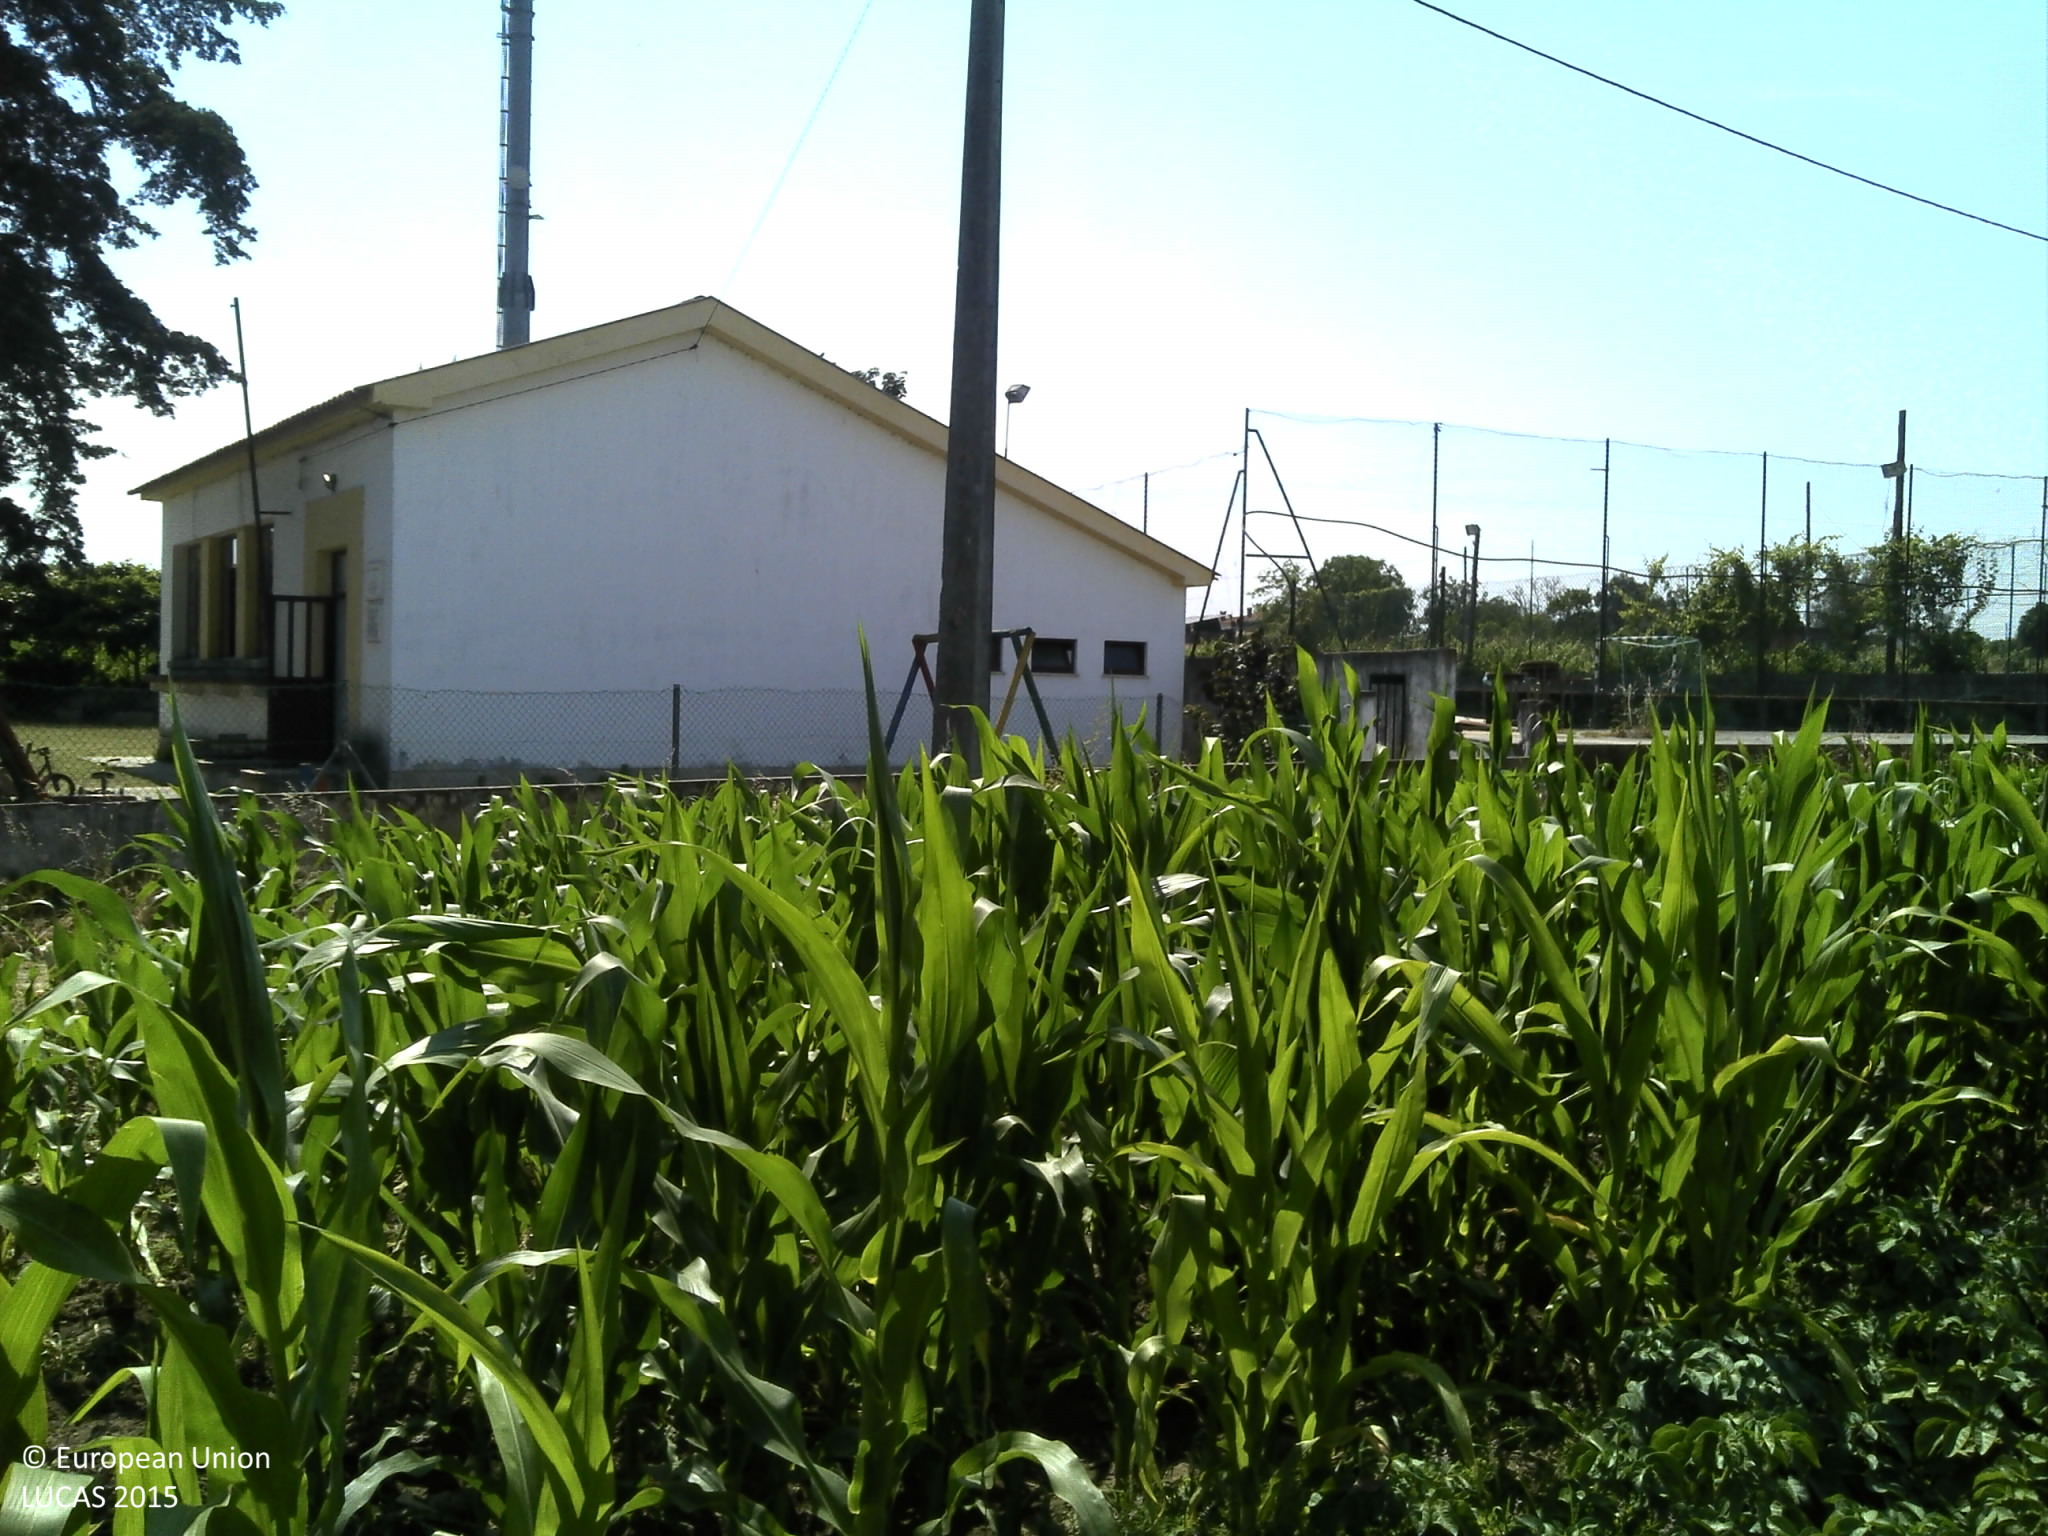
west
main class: Cropland
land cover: Potatoes
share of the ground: > 75 %
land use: Kitchen garden
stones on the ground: < 10 %
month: June
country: PT
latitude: 40.2203
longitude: -8.5481
